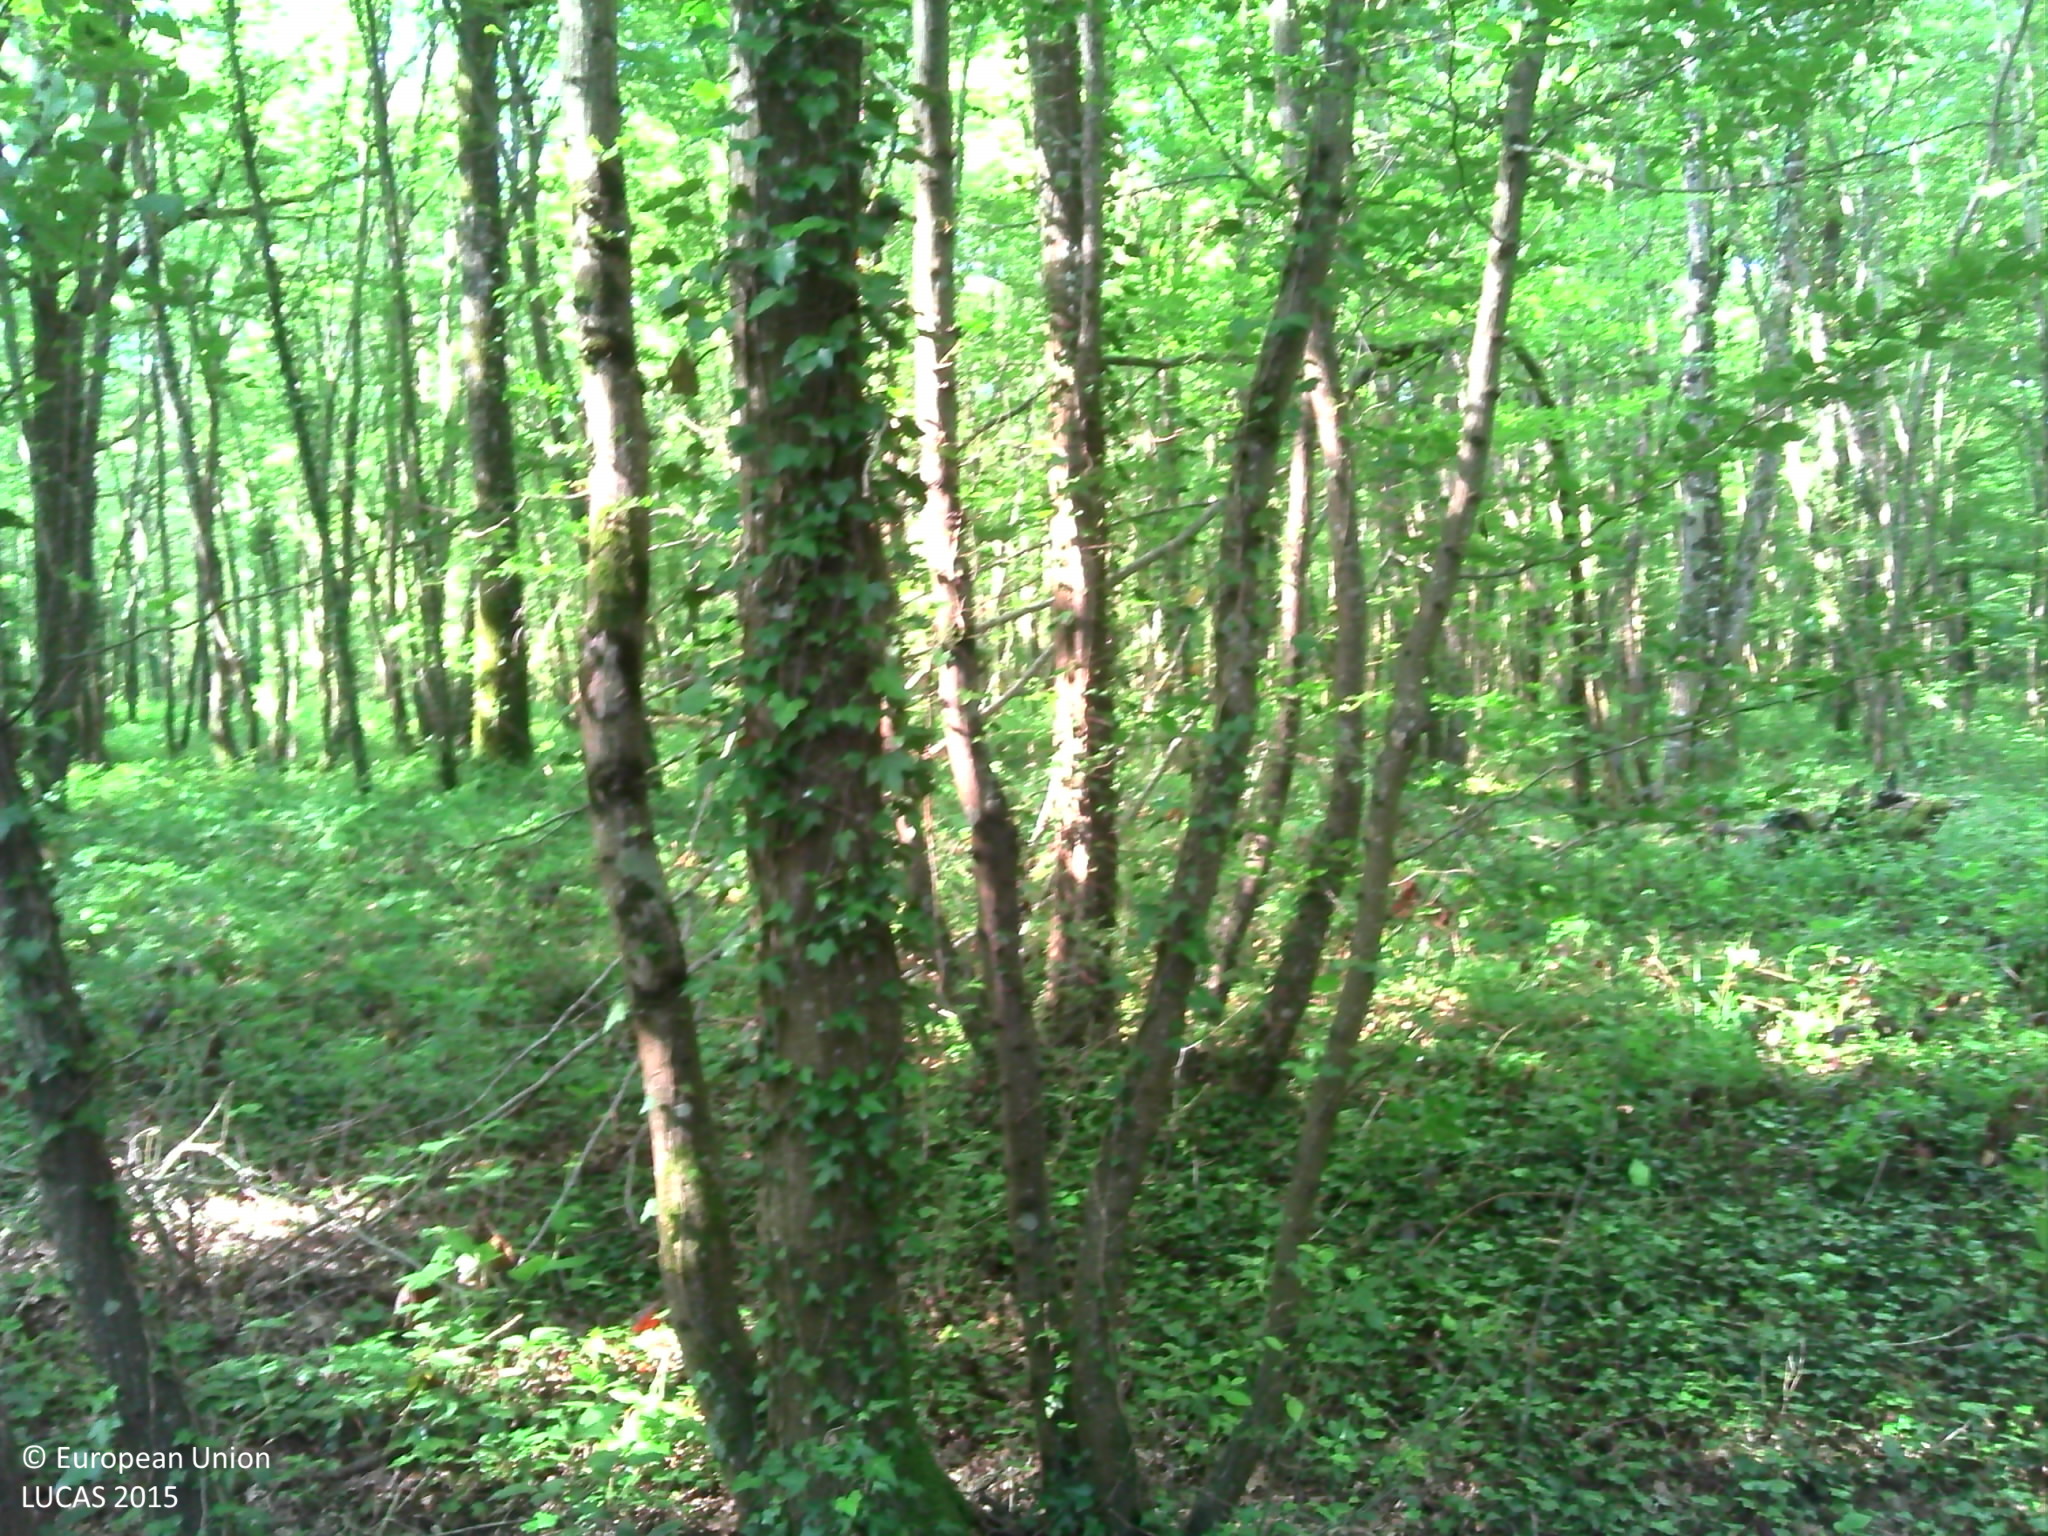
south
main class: Woodland
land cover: Broadleaved woodland
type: mesophytic deciduous forest
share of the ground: > 75 %
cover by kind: broadleaved forest trees 100 %
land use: Forestry
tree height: > 5 m
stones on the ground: < 10 %
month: June
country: FR
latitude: 47.0911
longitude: 2.6298
